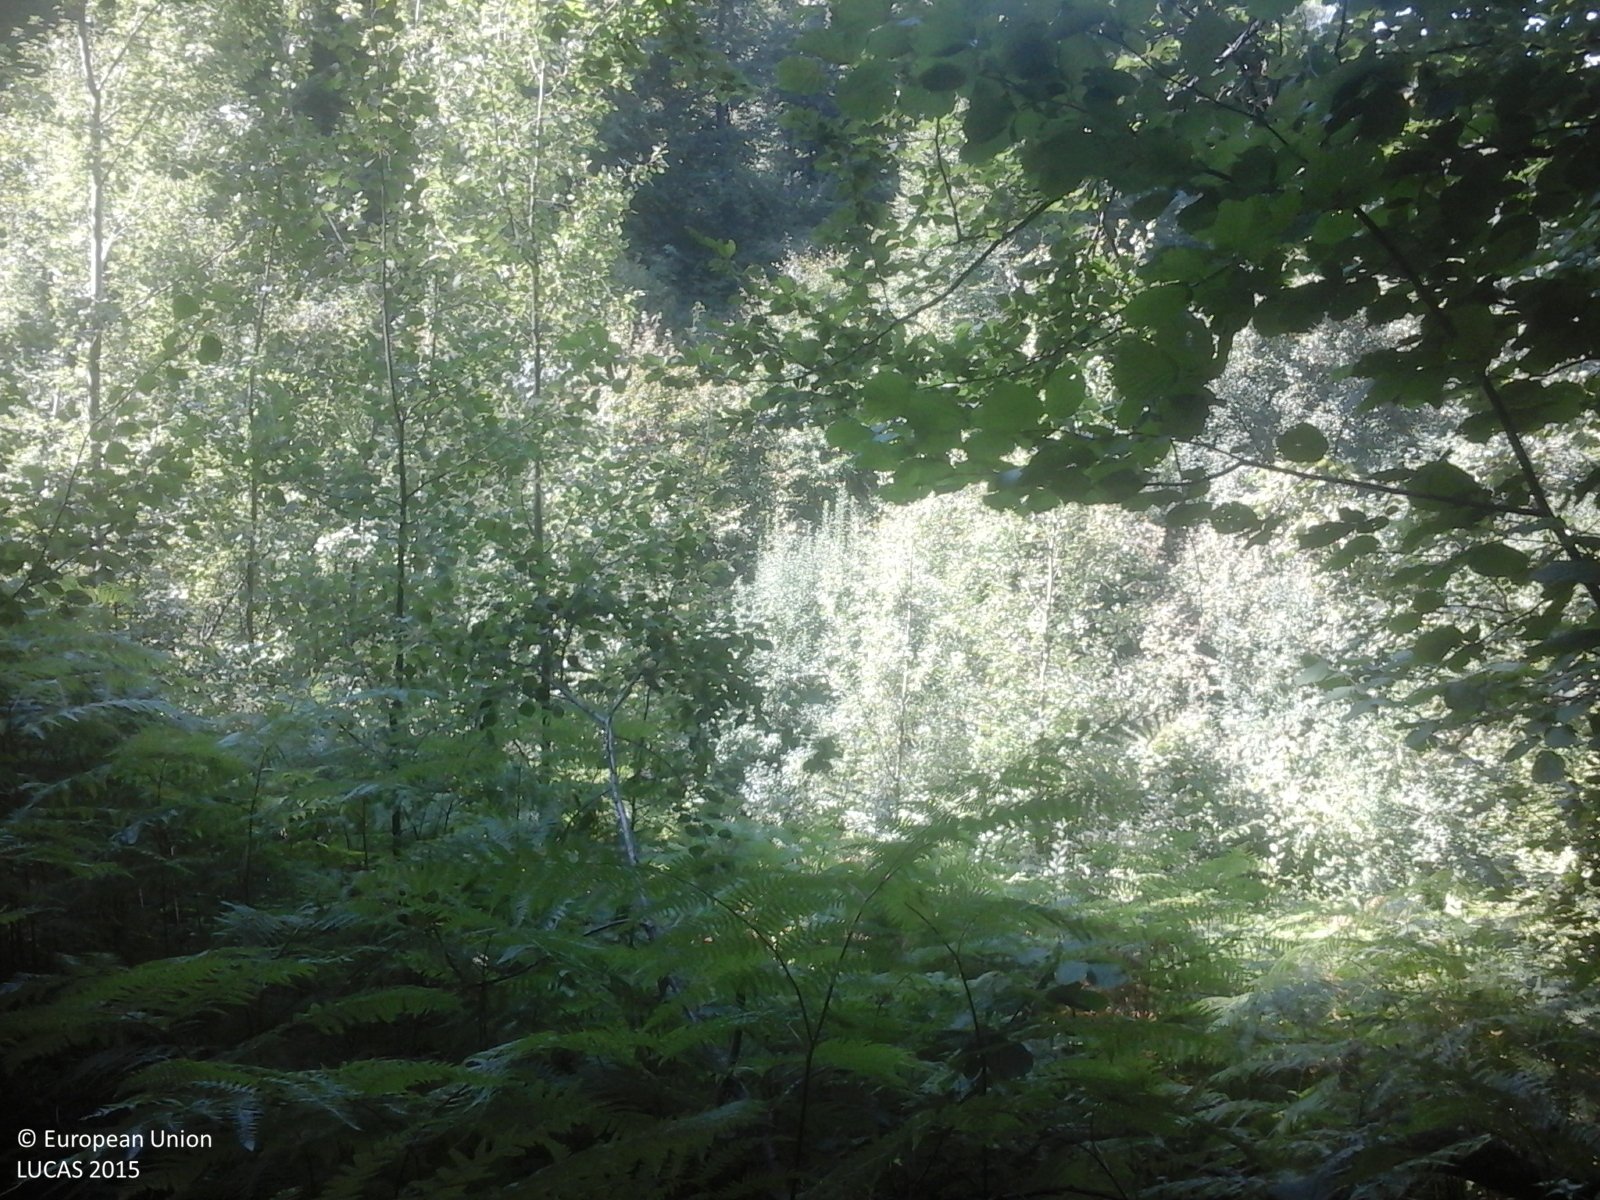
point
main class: Woodland
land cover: Broadleaved woodland
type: mesophytic deciduous forest
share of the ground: > 75 %
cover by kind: broadleaved forest trees 100 %
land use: Forestry
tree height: > 5 m
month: August
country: RO
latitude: 46.1471
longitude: 22.4648
